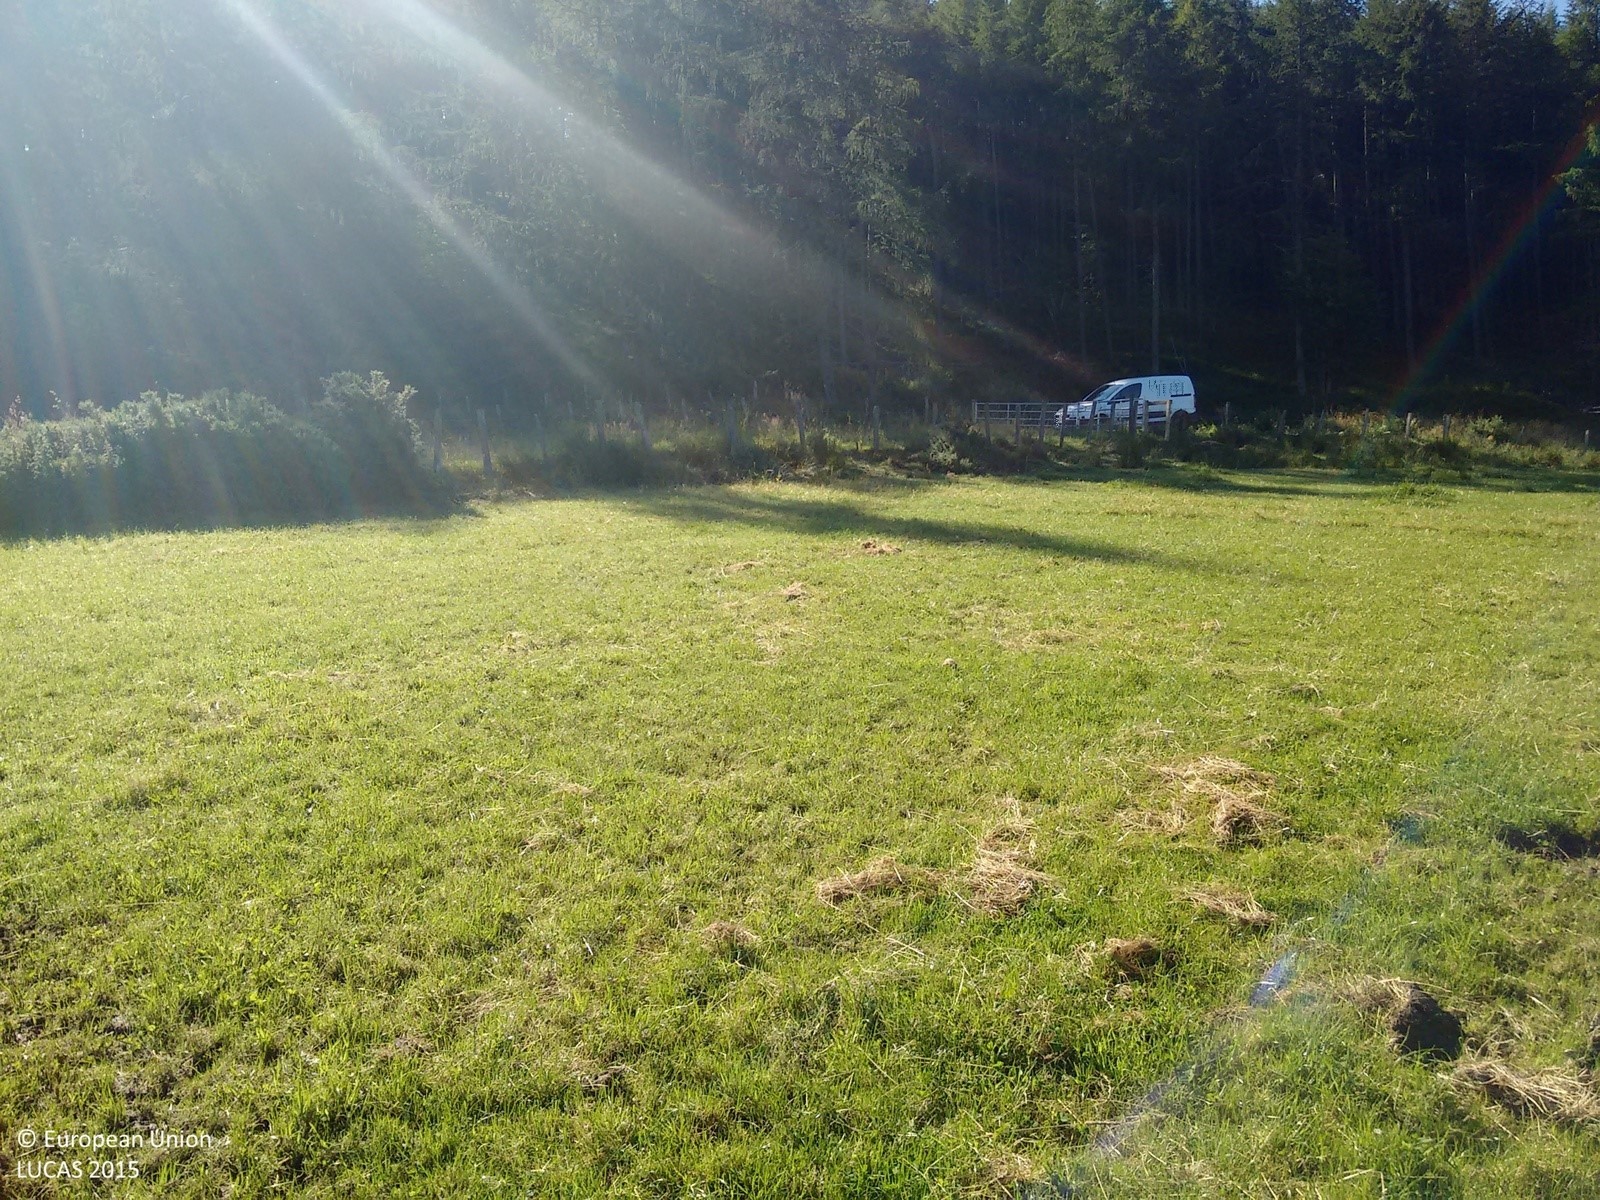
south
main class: Grassland
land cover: Grassland without tree/shrub cover
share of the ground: > 75 %
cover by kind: herbaceous plants 100 %
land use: Agriculture (excluding fallow land and kitchen gardens)
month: August
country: GB
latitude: 57.4700
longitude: -3.0509
